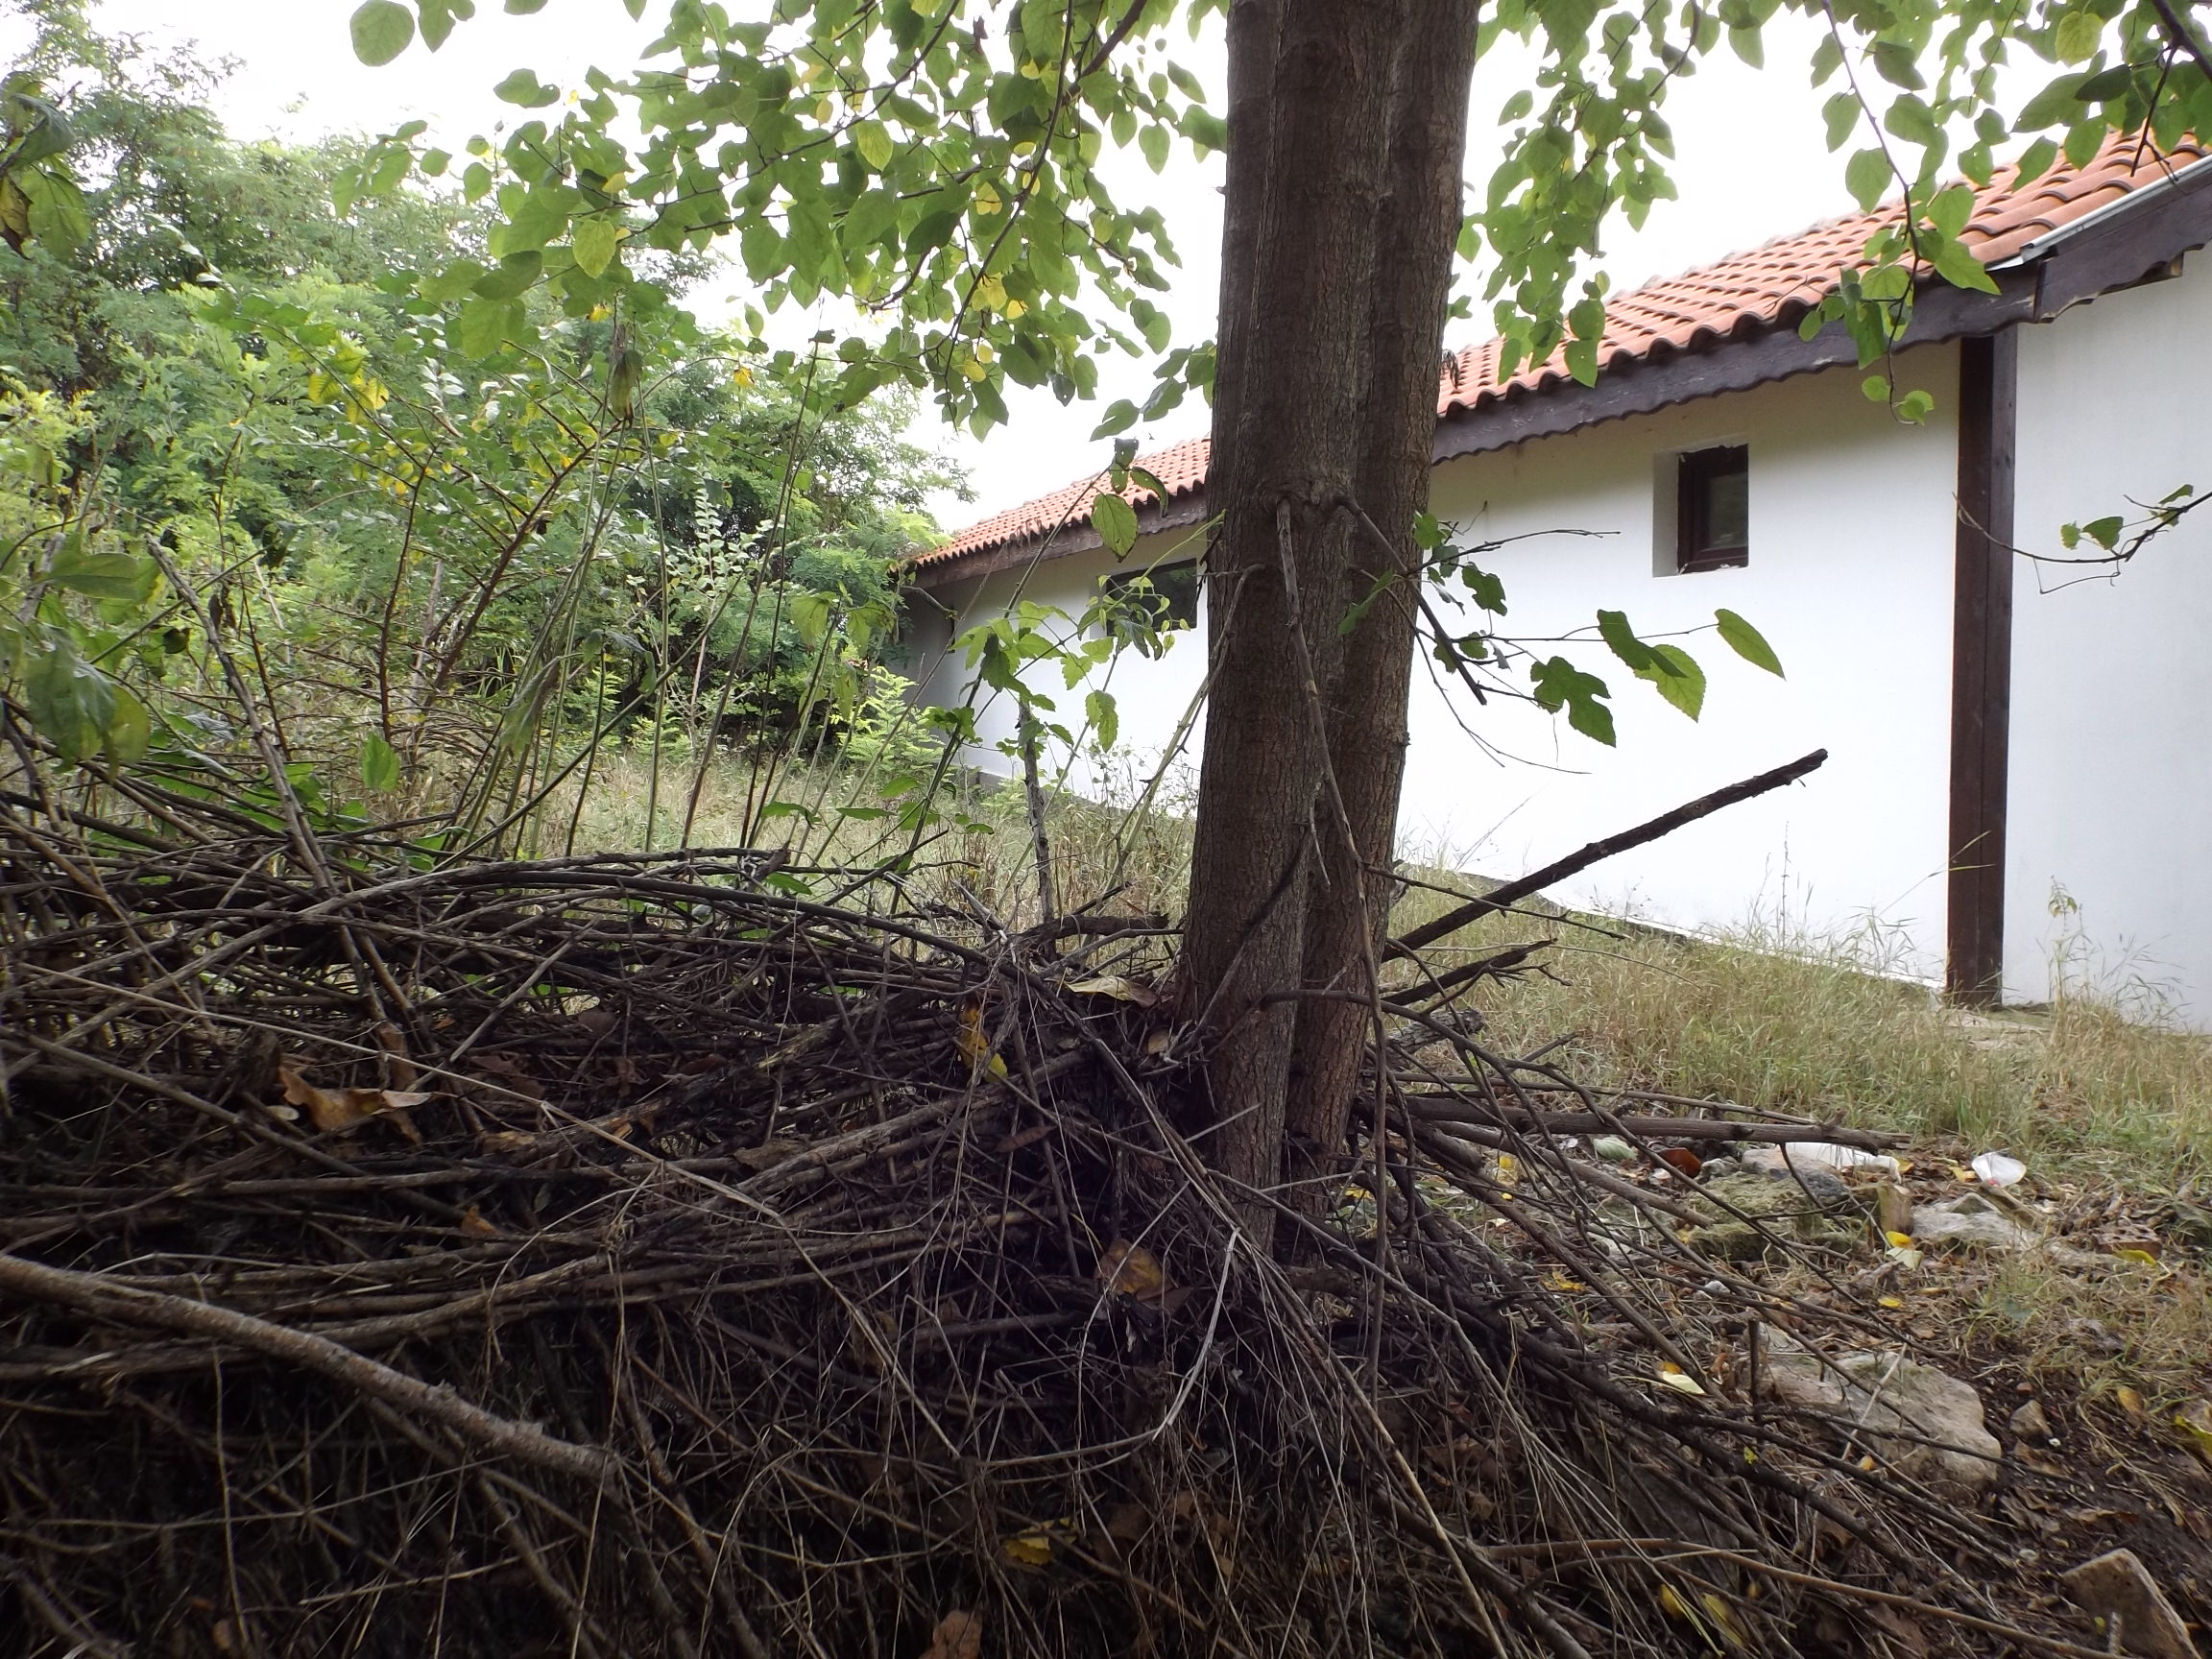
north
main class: Grassland
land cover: Grassland with sparse tree/shrub cover
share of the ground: > 75 %
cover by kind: herbaceous plants 90 %, broadleaved forest trees 5 %, shrubs 5 %
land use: Residential
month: August
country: BG
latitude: 43.1790
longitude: 27.5107
